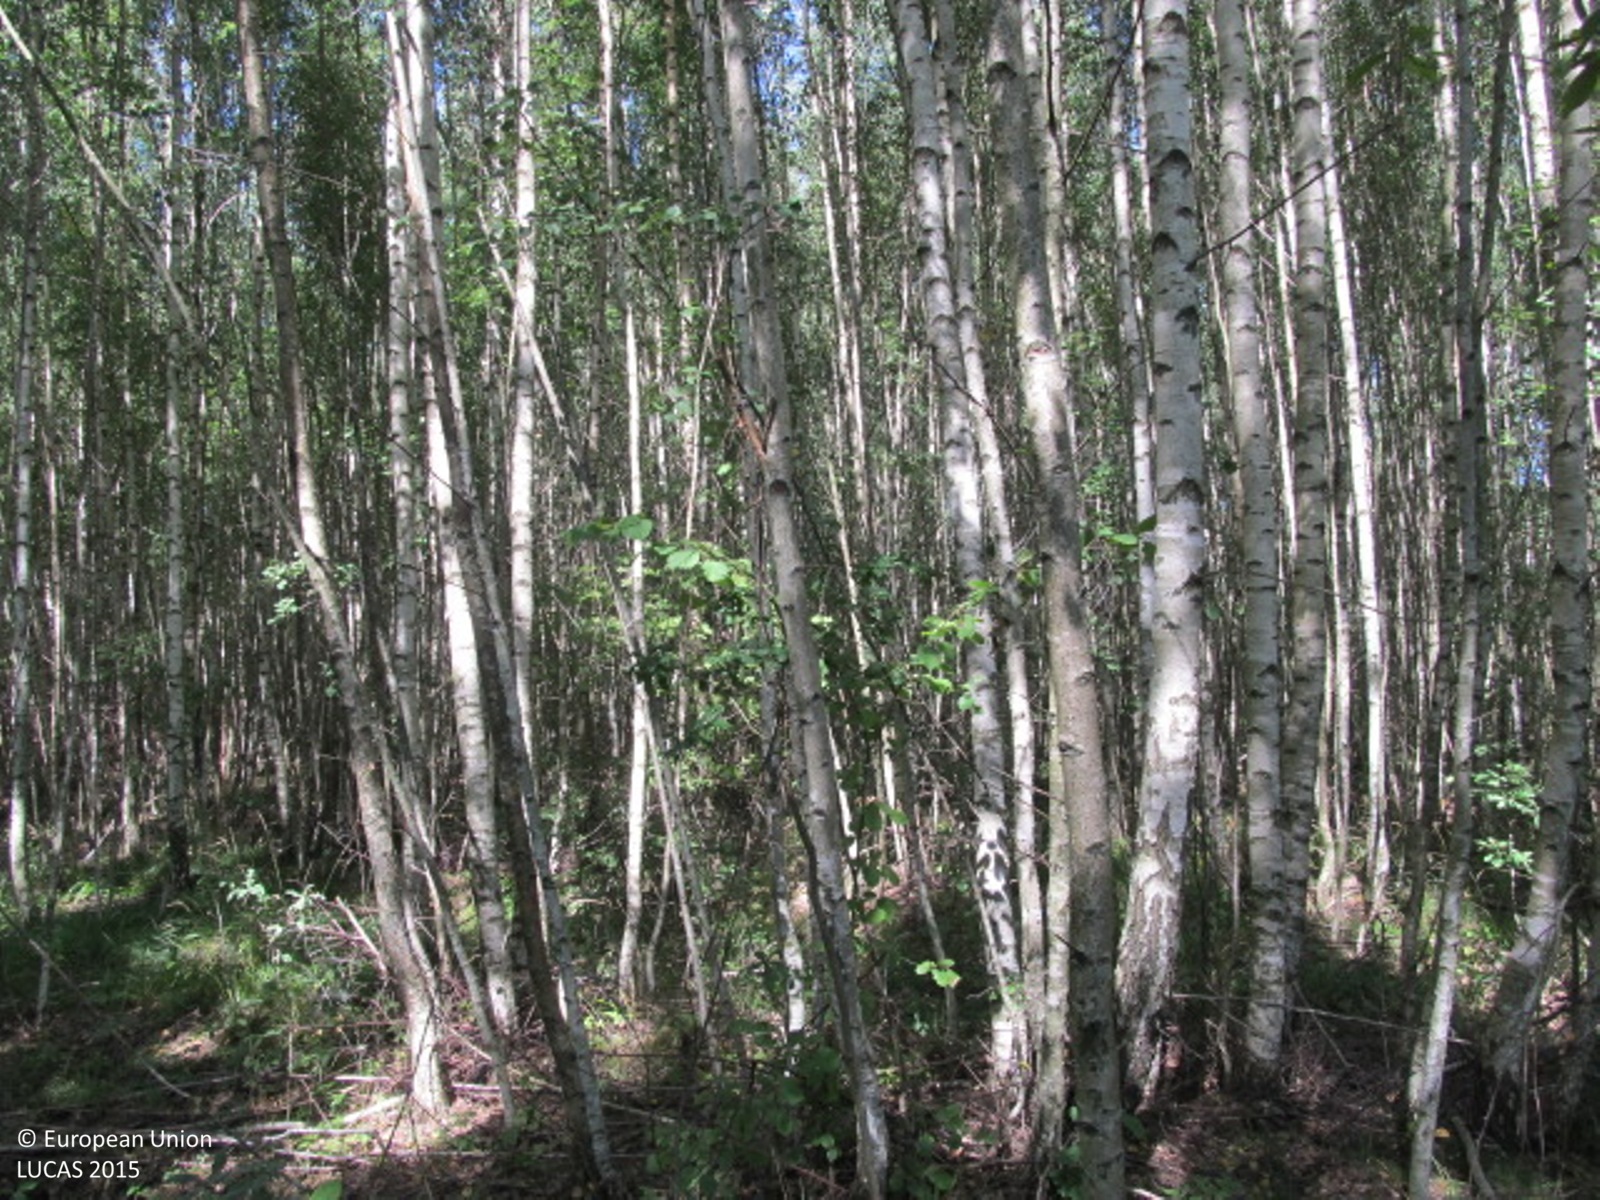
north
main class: Woodland
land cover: Broadleaved woodland
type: non-riverine alder, birch or aspen forest
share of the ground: > 75 %
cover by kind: broadleaved forest trees 85 %, herbaceous plants 10 %, shrubs 5 %
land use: Forestry
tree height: > 5 m
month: August
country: LT
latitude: 56.1385
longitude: 22.4981
